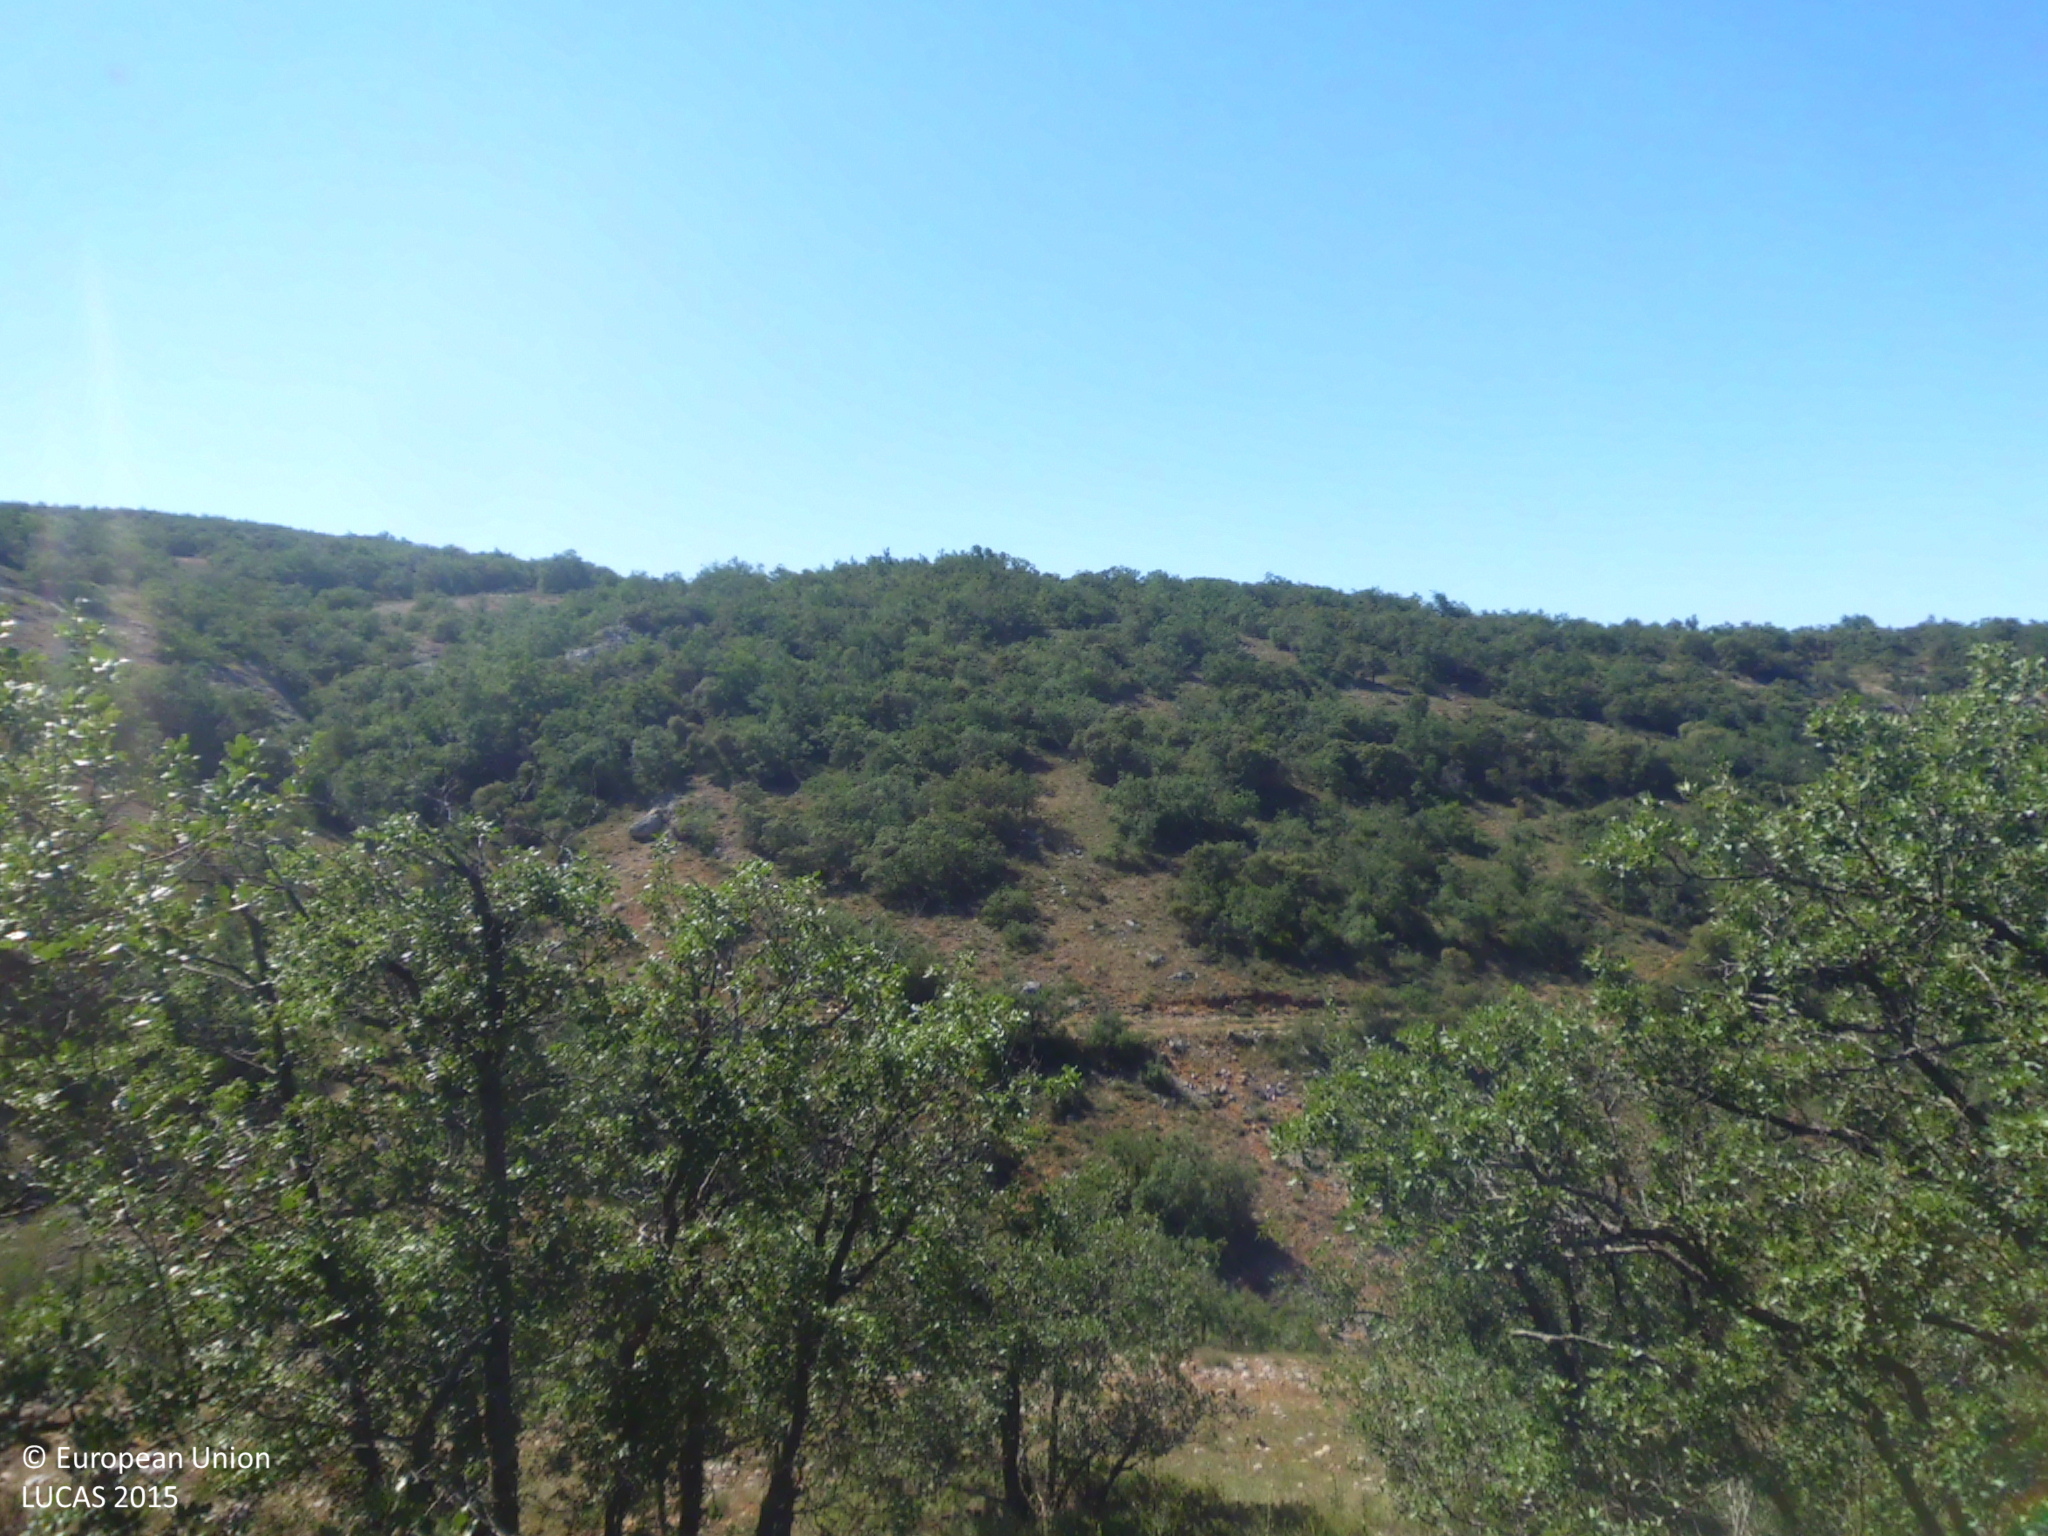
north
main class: Woodland
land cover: Broadleaved woodland
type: broadleaved evergreen forest
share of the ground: 25 - 50 %
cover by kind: broadleaved forest trees 40 %, herbaceous plants 30 %, consolidated bare surface 20 %, shrubs 10 %
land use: Semi-natural and natural areas not in use
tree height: > 5 m
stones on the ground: 10 - 25 %
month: July
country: ES
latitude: 42.7953
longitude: -4.3689
